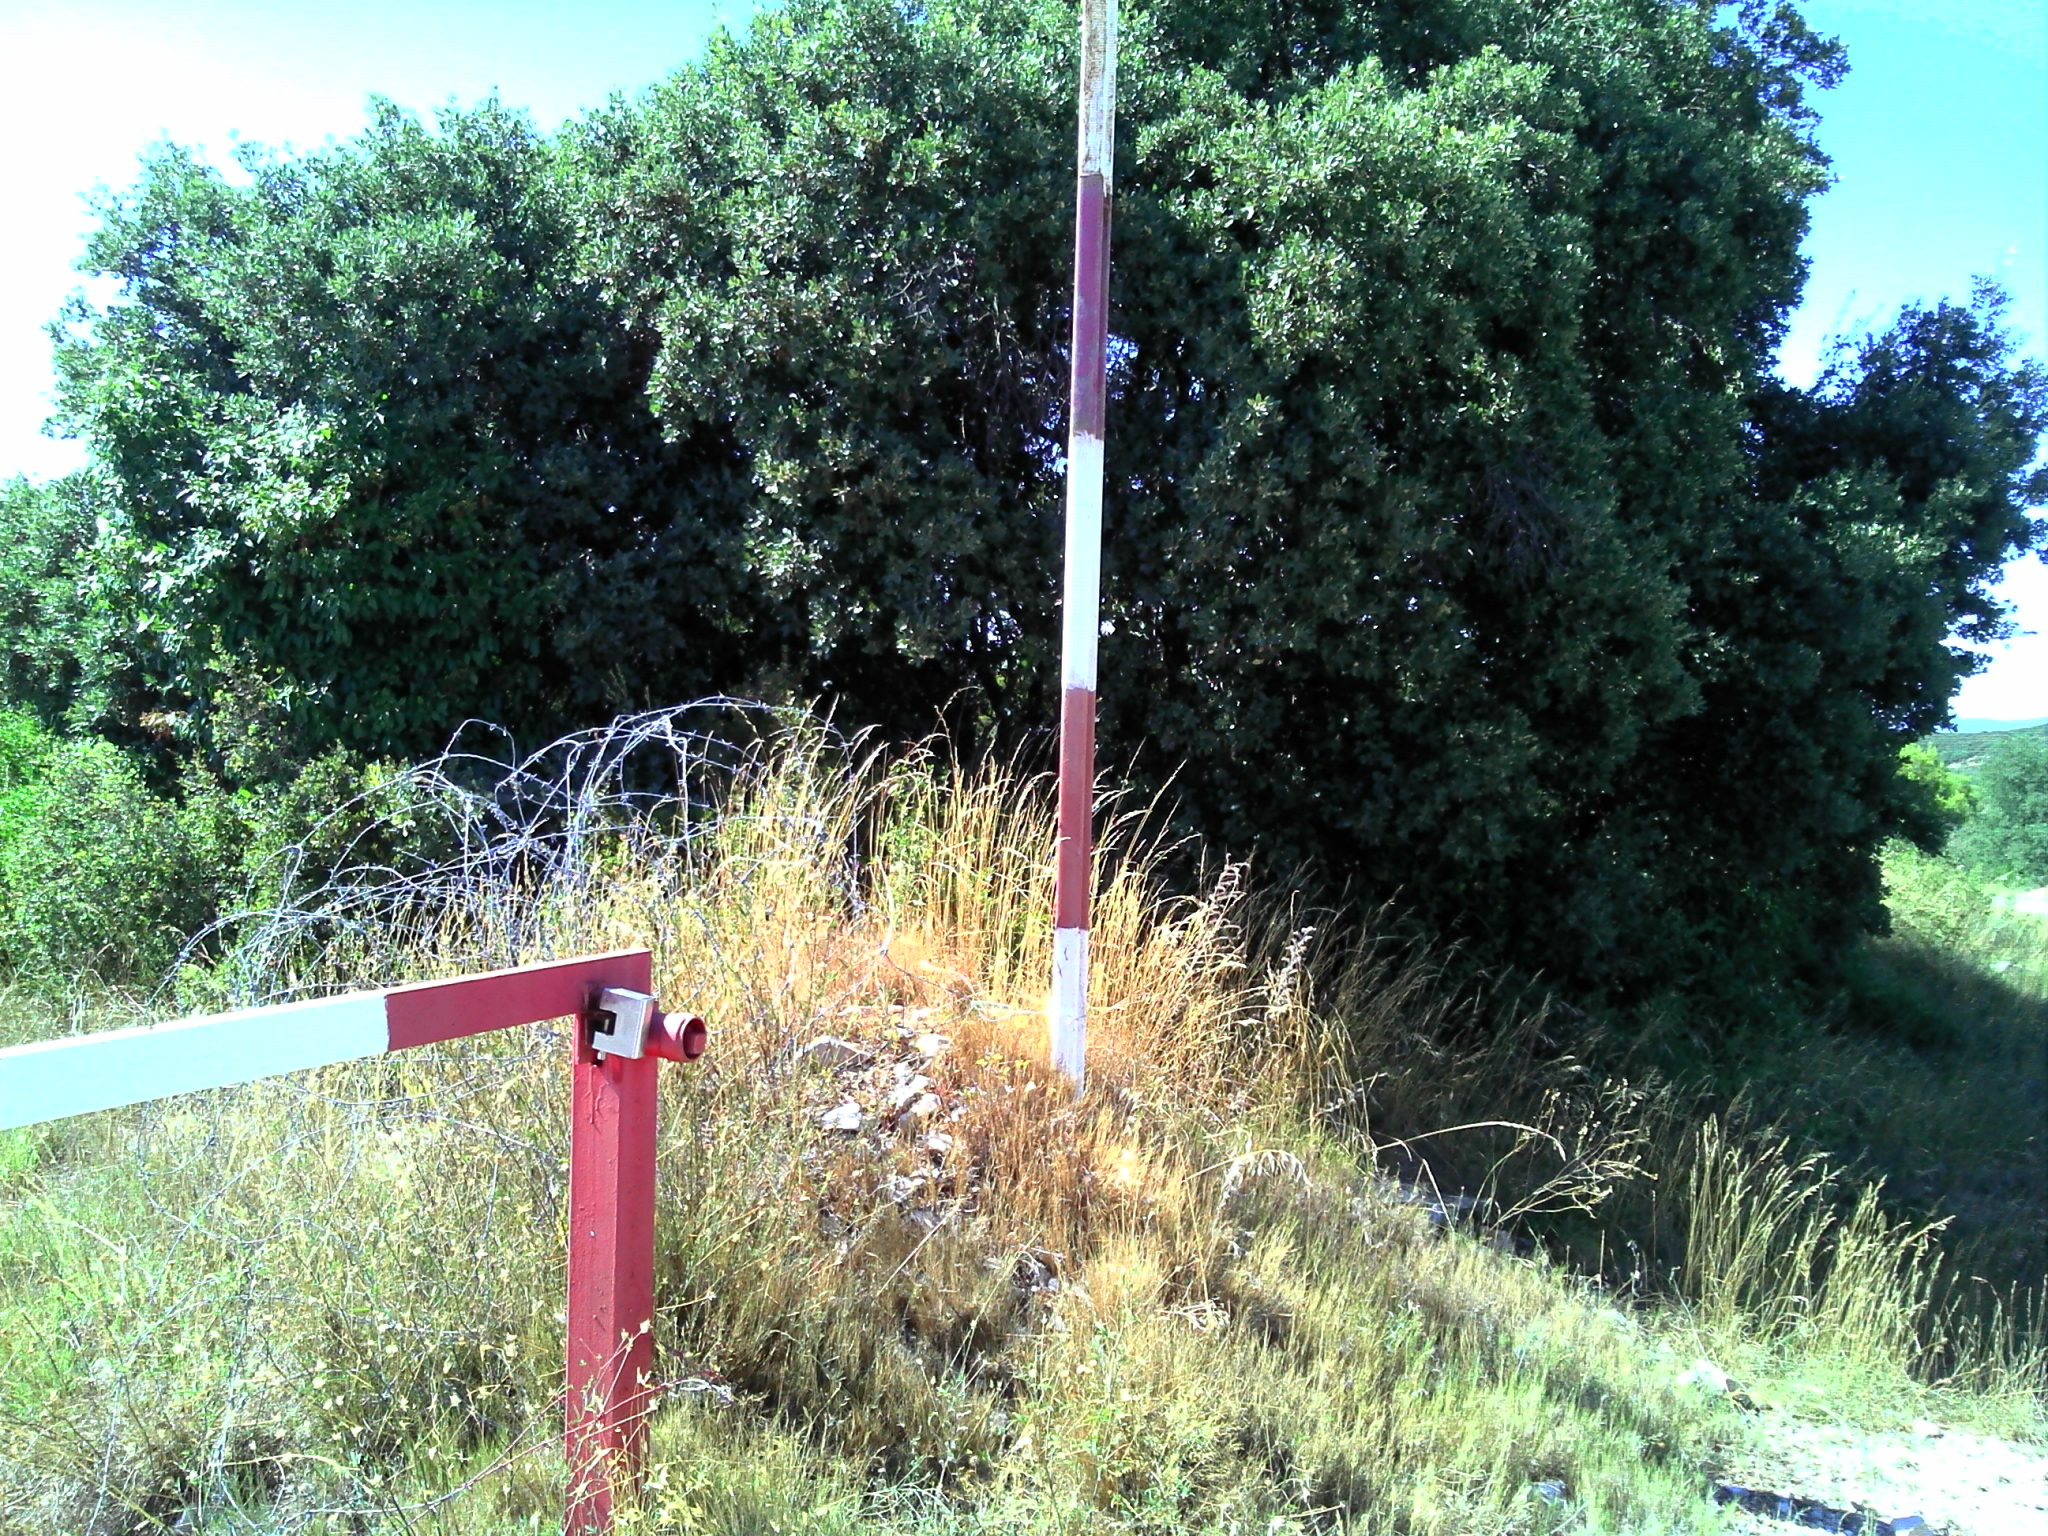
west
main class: Shrubland
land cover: Shrubland with sparse tree cover
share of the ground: 50 - 75 %
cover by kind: shrubs 50 %, herbaceous plants 45 %, broadleaved forest trees 5 %
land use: Community services
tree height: > 5 m
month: July
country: FR
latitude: 43.8876
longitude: 4.3201
